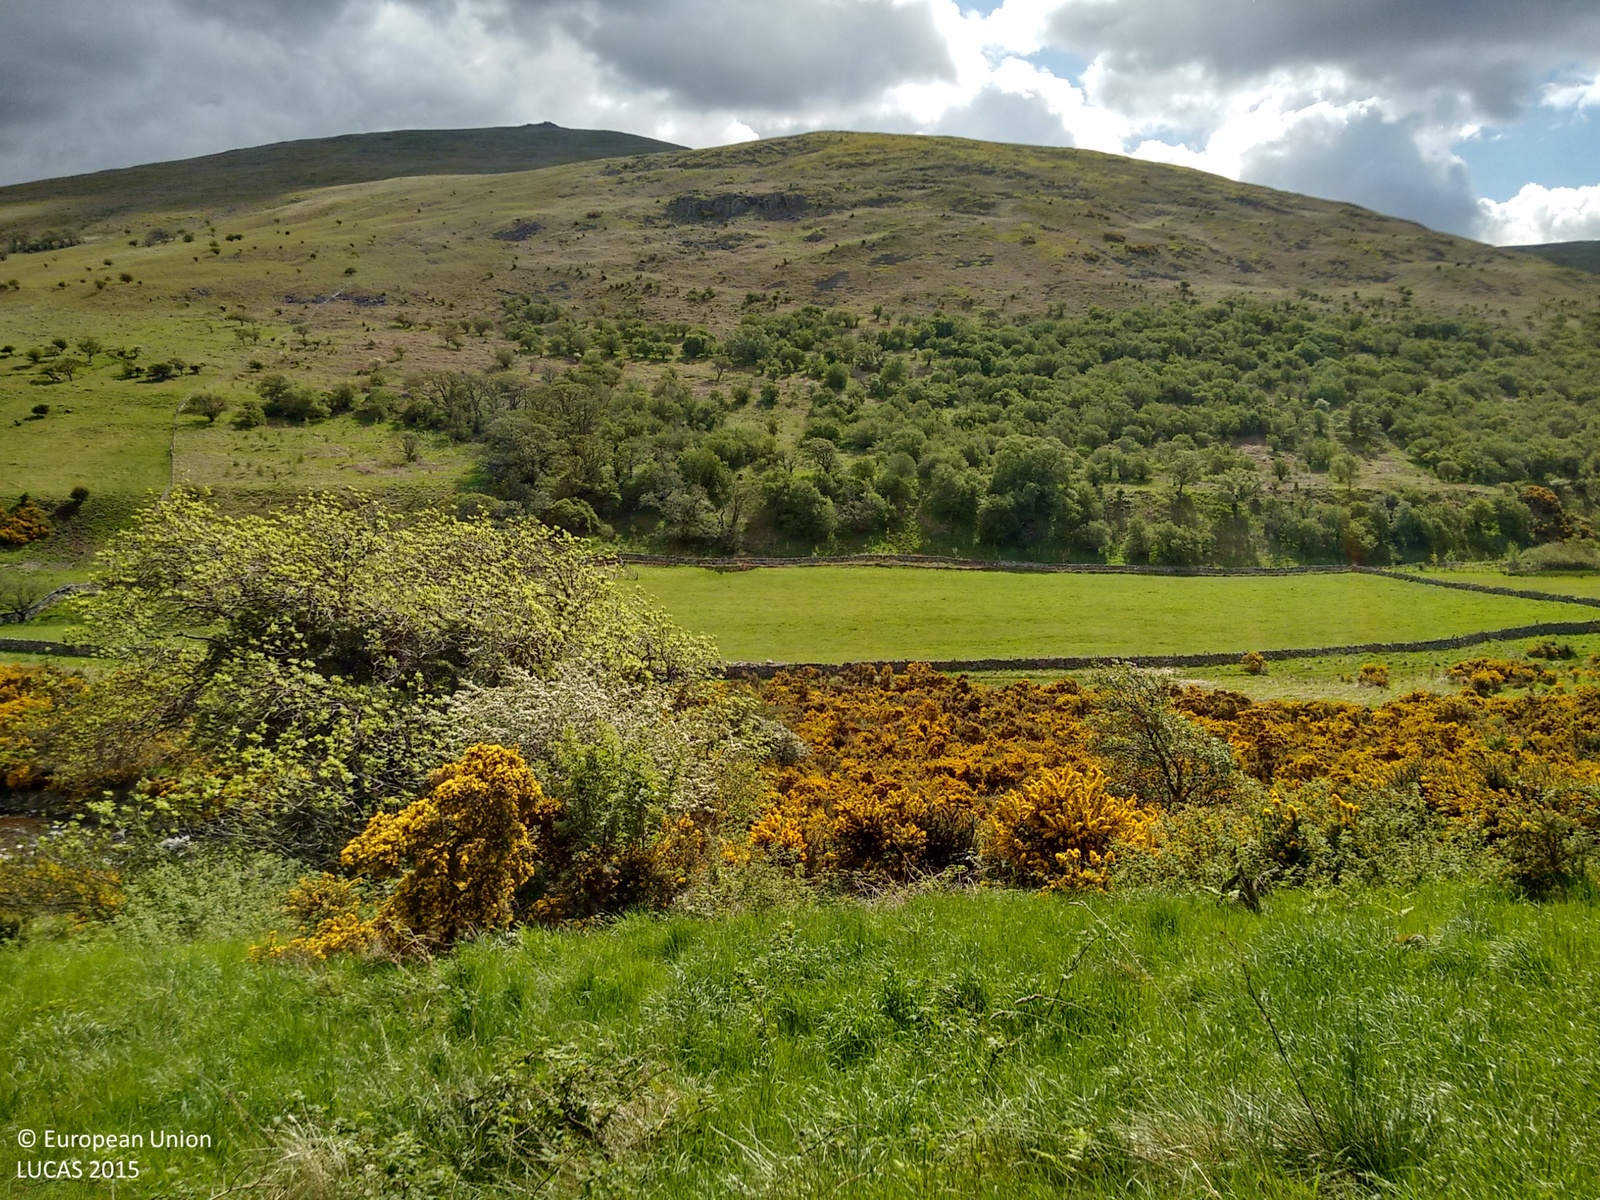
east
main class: Grassland
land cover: Grassland without tree/shrub cover
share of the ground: > 75 %
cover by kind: herbaceous plants 100 %
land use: Agriculture (excluding fallow land and kitchen gardens)
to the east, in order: Grassland without tree/shrub cover; Dry stone walls; Broadleaved woodland; Grassland with sparse tree/shrub cover
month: June
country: GB
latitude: 55.5325
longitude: -2.1761
